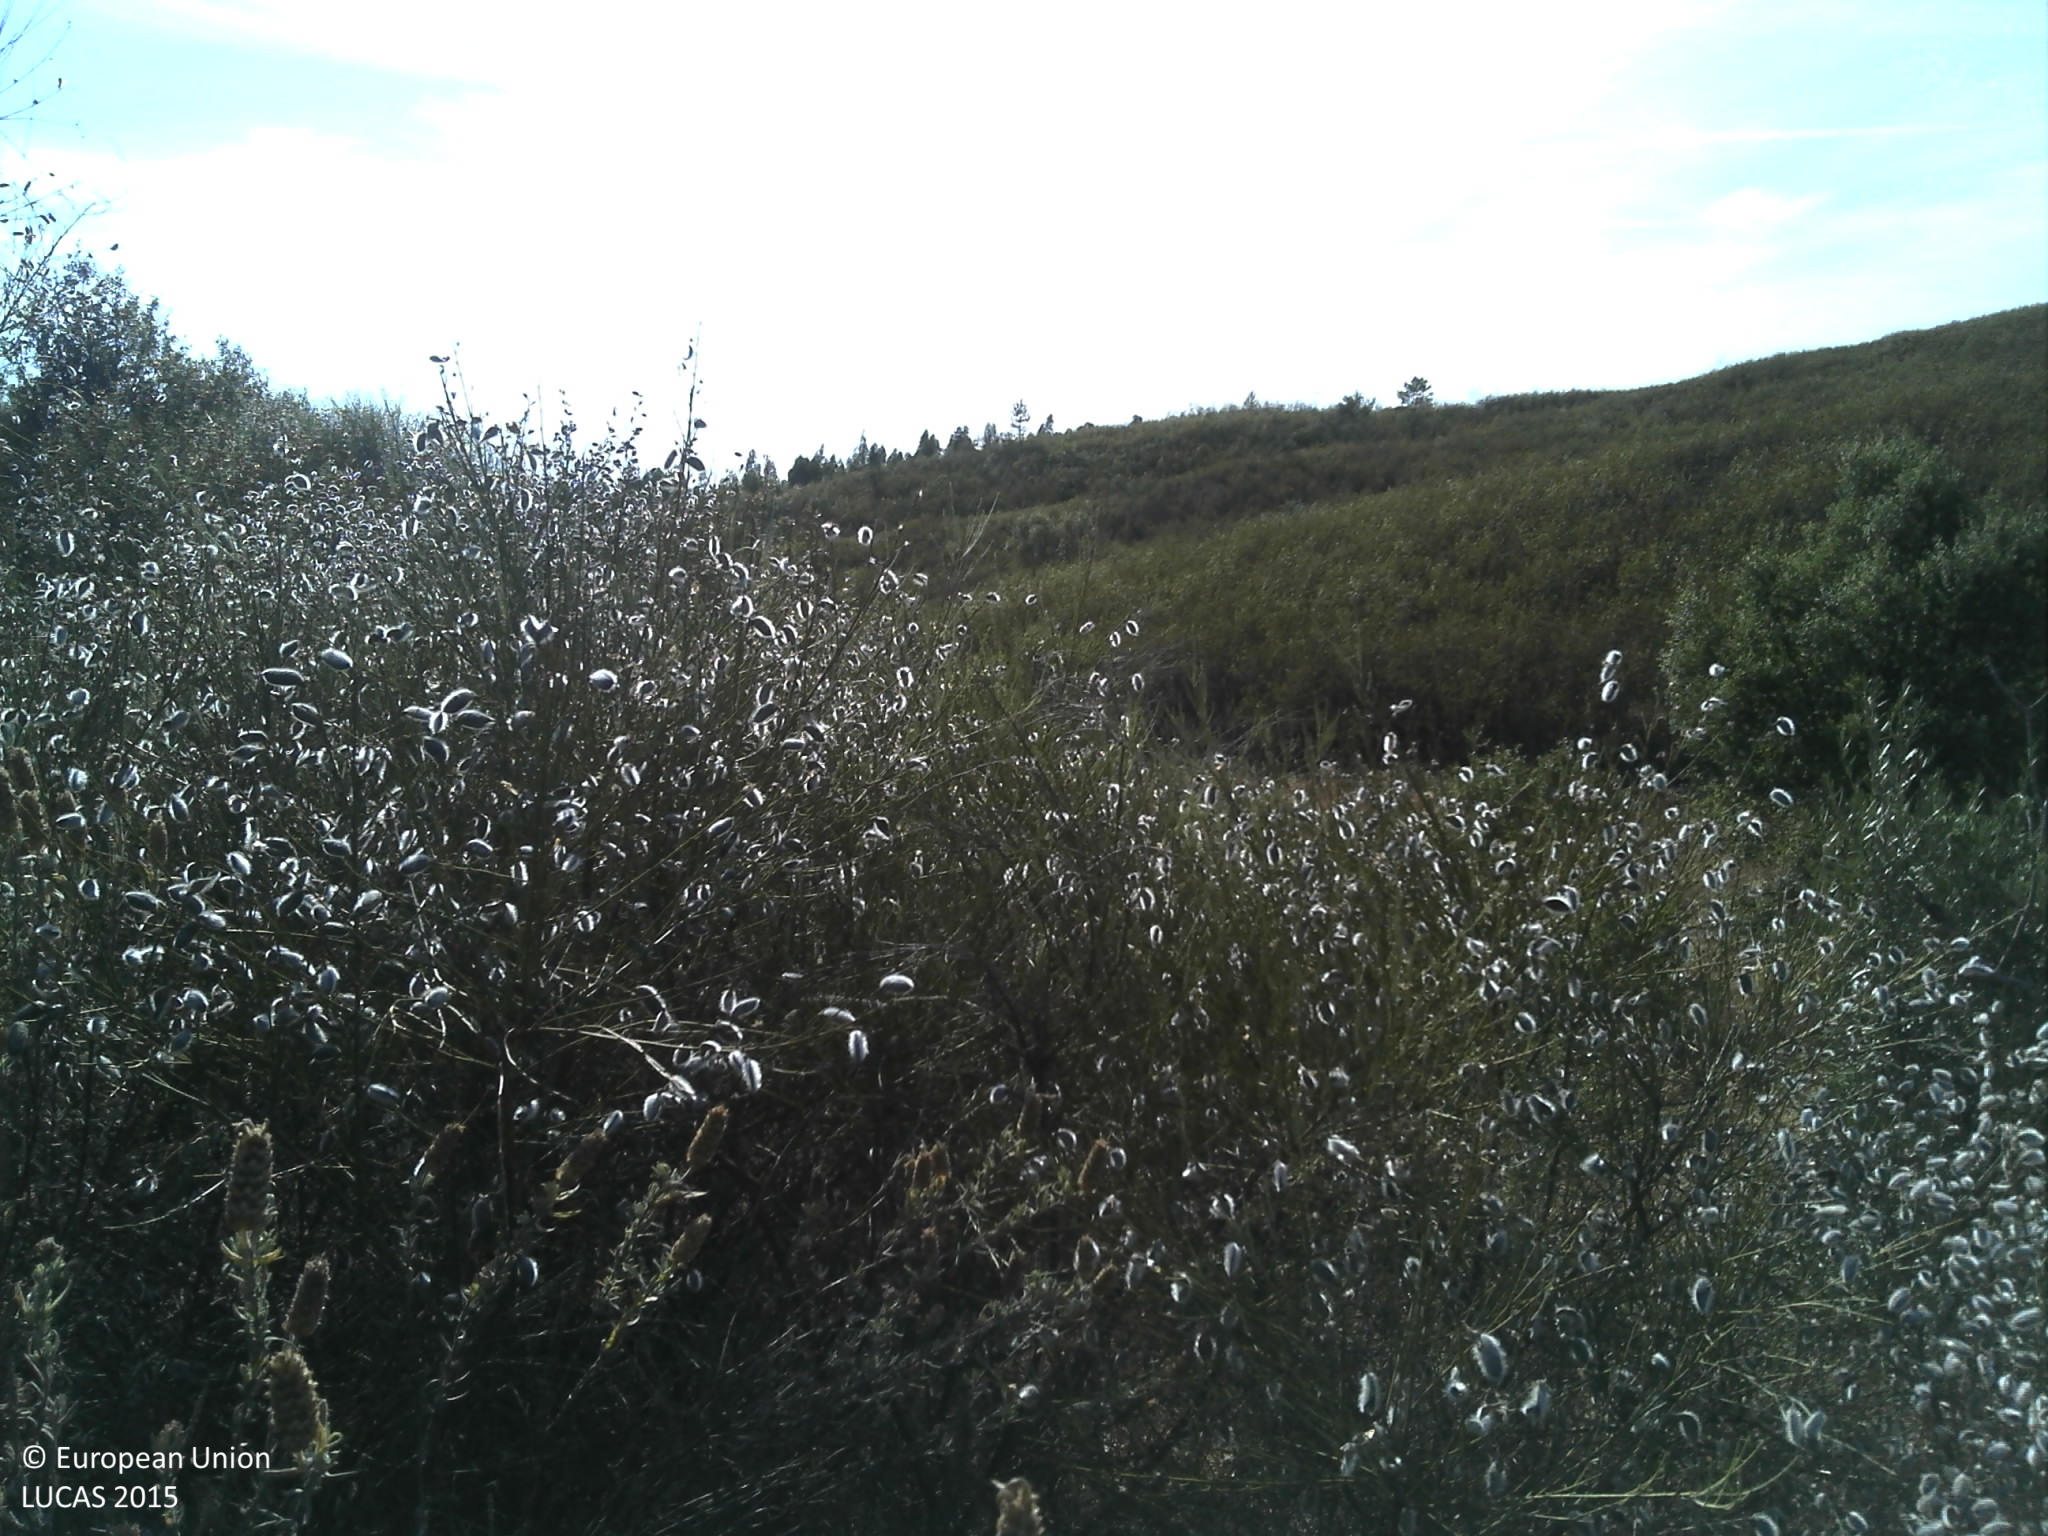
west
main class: Shrubland
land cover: Shrubland with sparse tree cover
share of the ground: > 75 %
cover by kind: shrubs 80 %, herbaceous plants 10 %, broadleaved forest trees 5 %, unconsolidated bare surface 5 %
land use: Semi-natural and natural areas not in use
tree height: < 5 m
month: July
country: PT
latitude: 39.6268
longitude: -7.7757
